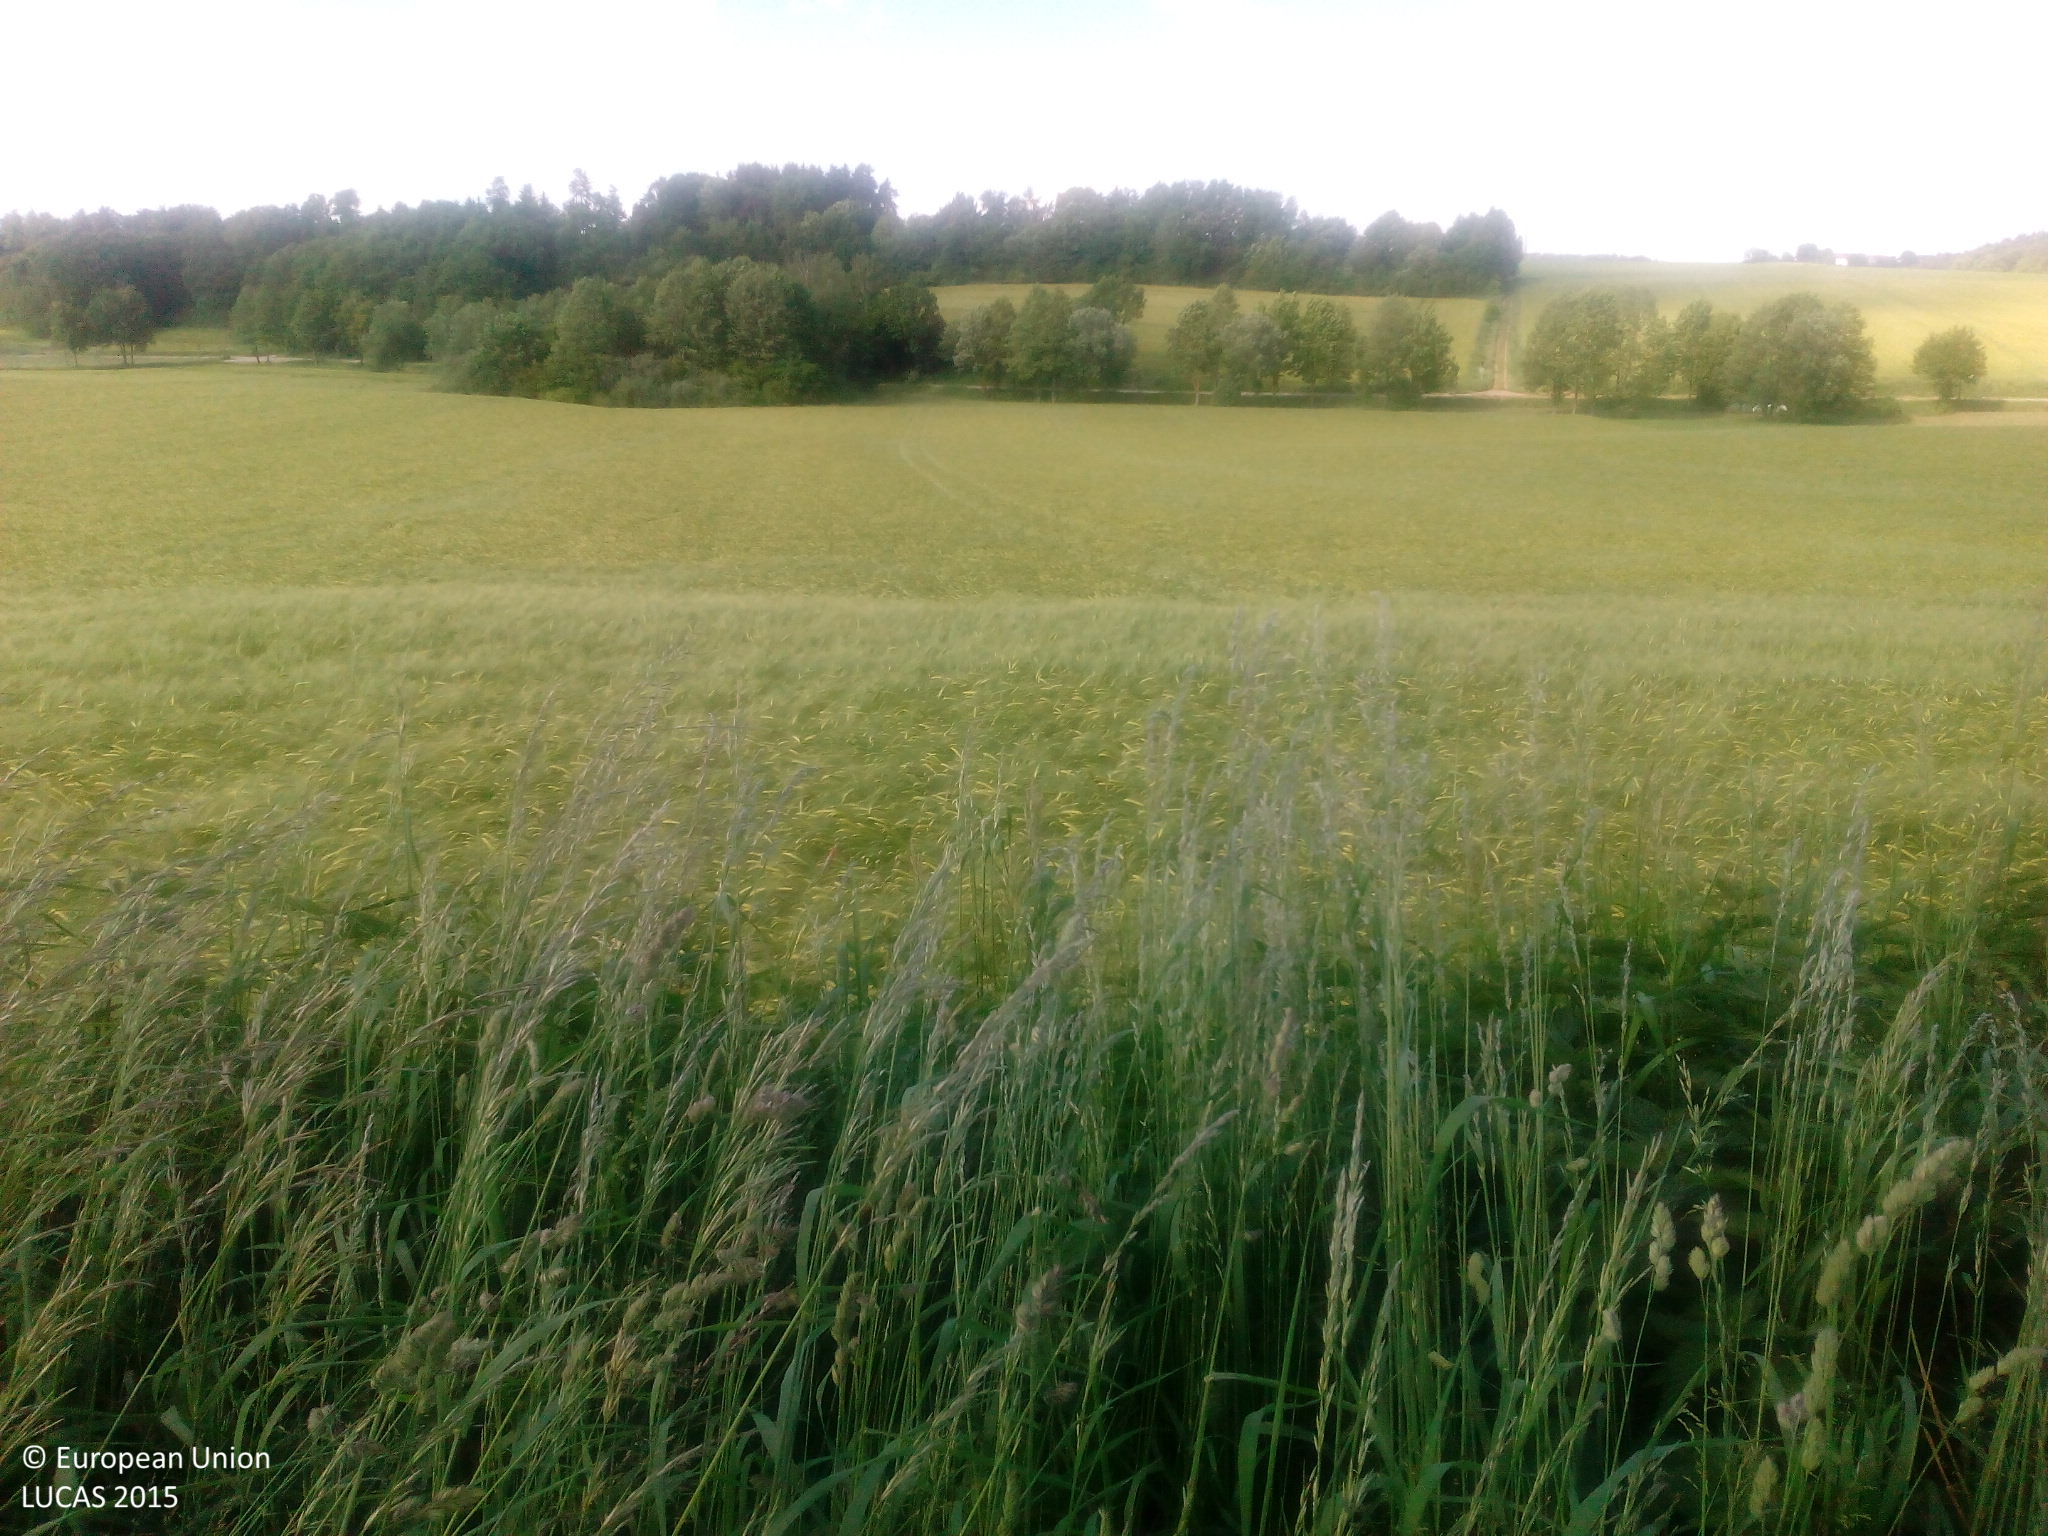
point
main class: Cropland
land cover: Rye
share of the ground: > 75 %
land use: Agriculture (excluding fallow land and kitchen gardens)
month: June
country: DE
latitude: 48.7439
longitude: 12.0799
